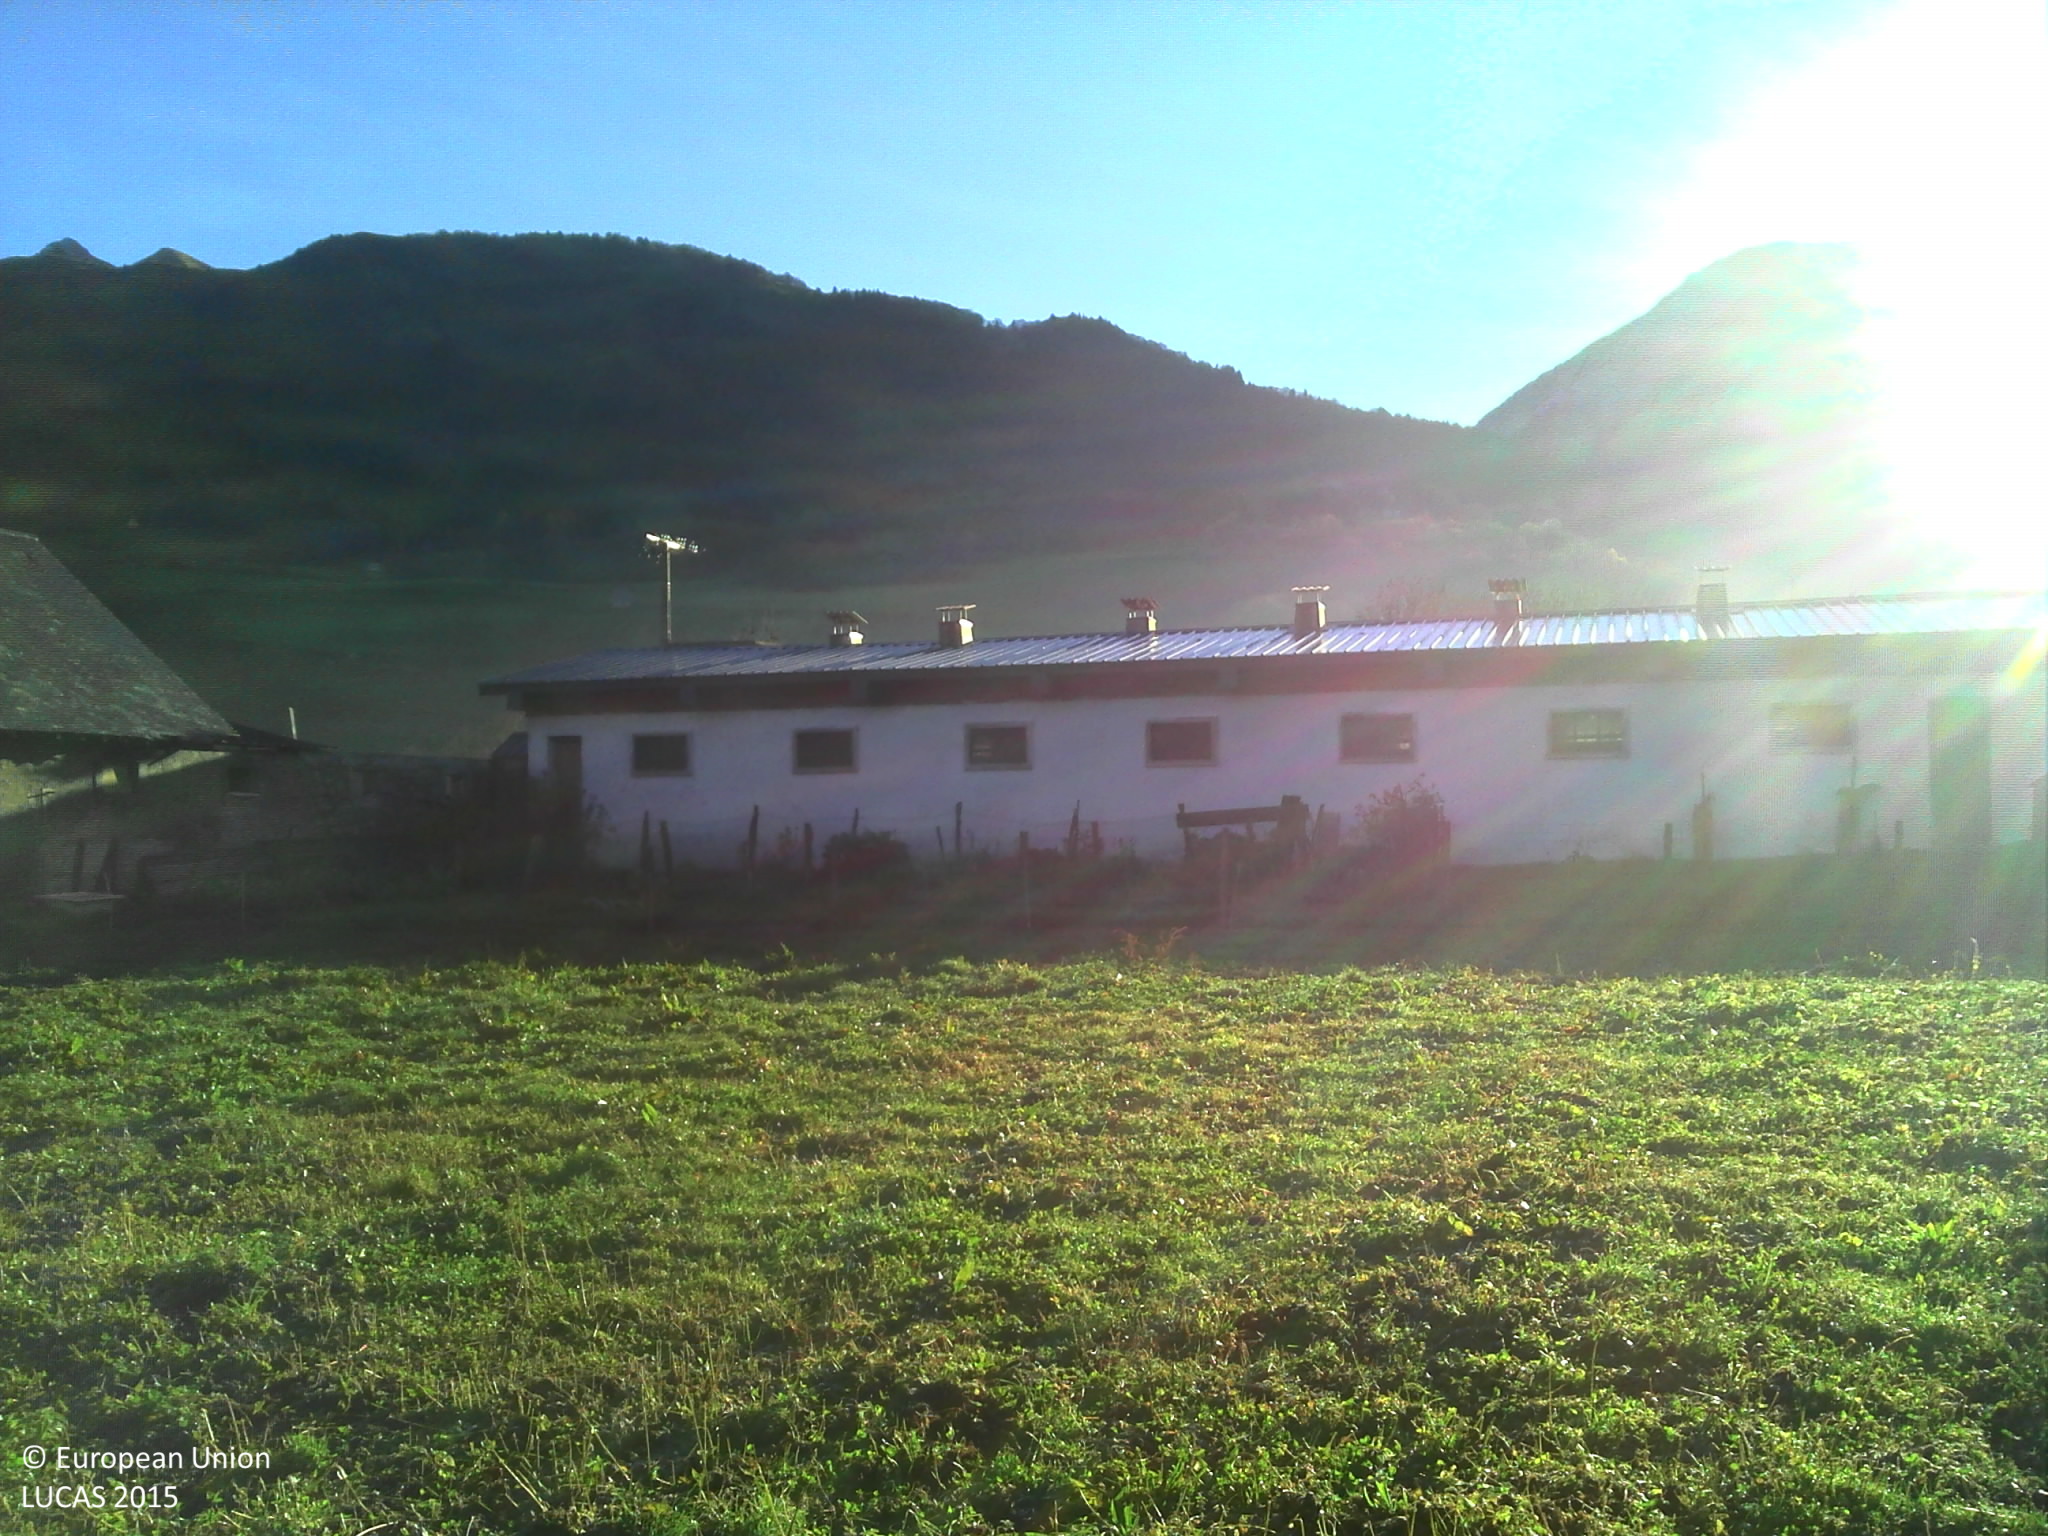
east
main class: Grassland
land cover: Grassland without tree/shrub cover
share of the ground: > 75 %
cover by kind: herbaceous plants 95 %, unconsolidated bare surface 5 %
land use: Agriculture (excluding fallow land and kitchen gardens)
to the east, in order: Grassland without tree/shrub cover; Artificial constructions in urban areas; Grassland without tree/shrub cover; Fences; Broadleaved woodland; Spontaneously vegetated surfaces; Grassland with sparse tree/shrub cover; Grassland without tree/shrub cover; Electric lines; Grassland without tree/shrub cover; Broadleaved woodland
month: November
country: FR
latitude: 45.6513
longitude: 6.1676
